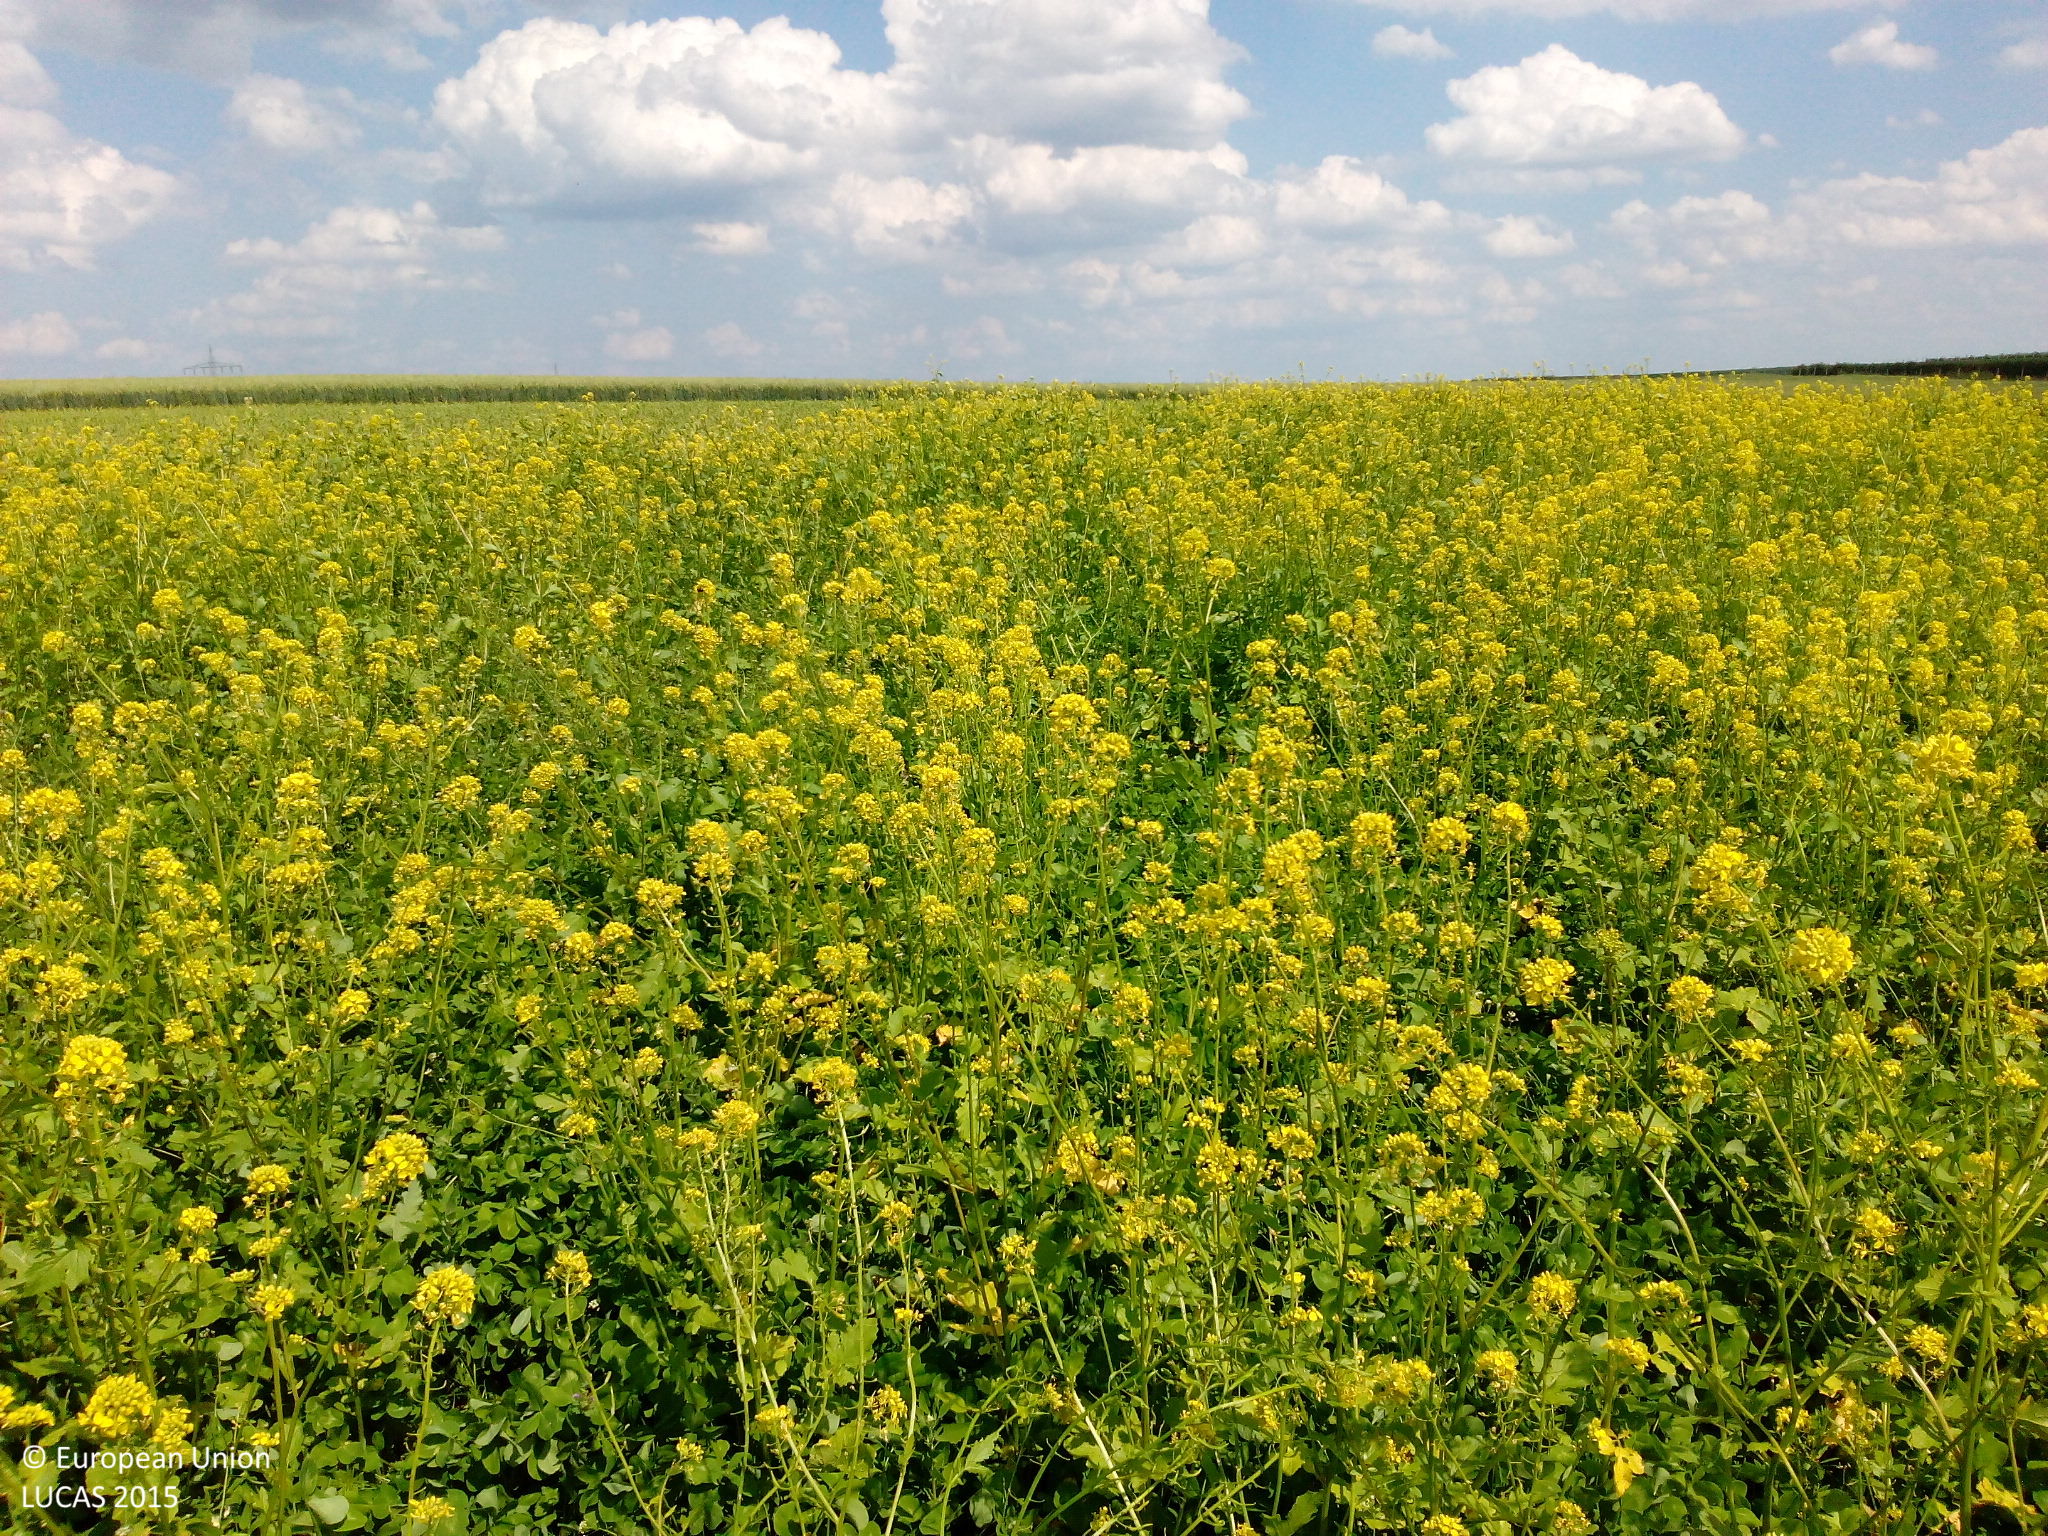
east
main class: Cropland
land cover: Rape and turnip rape
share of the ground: > 75 %
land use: Agriculture (excluding fallow land and kitchen gardens)
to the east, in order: Rape and turnip rape; Clovers; Maize; Barley; Common wheat
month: June
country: DE
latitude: 48.8547
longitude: 11.9210
